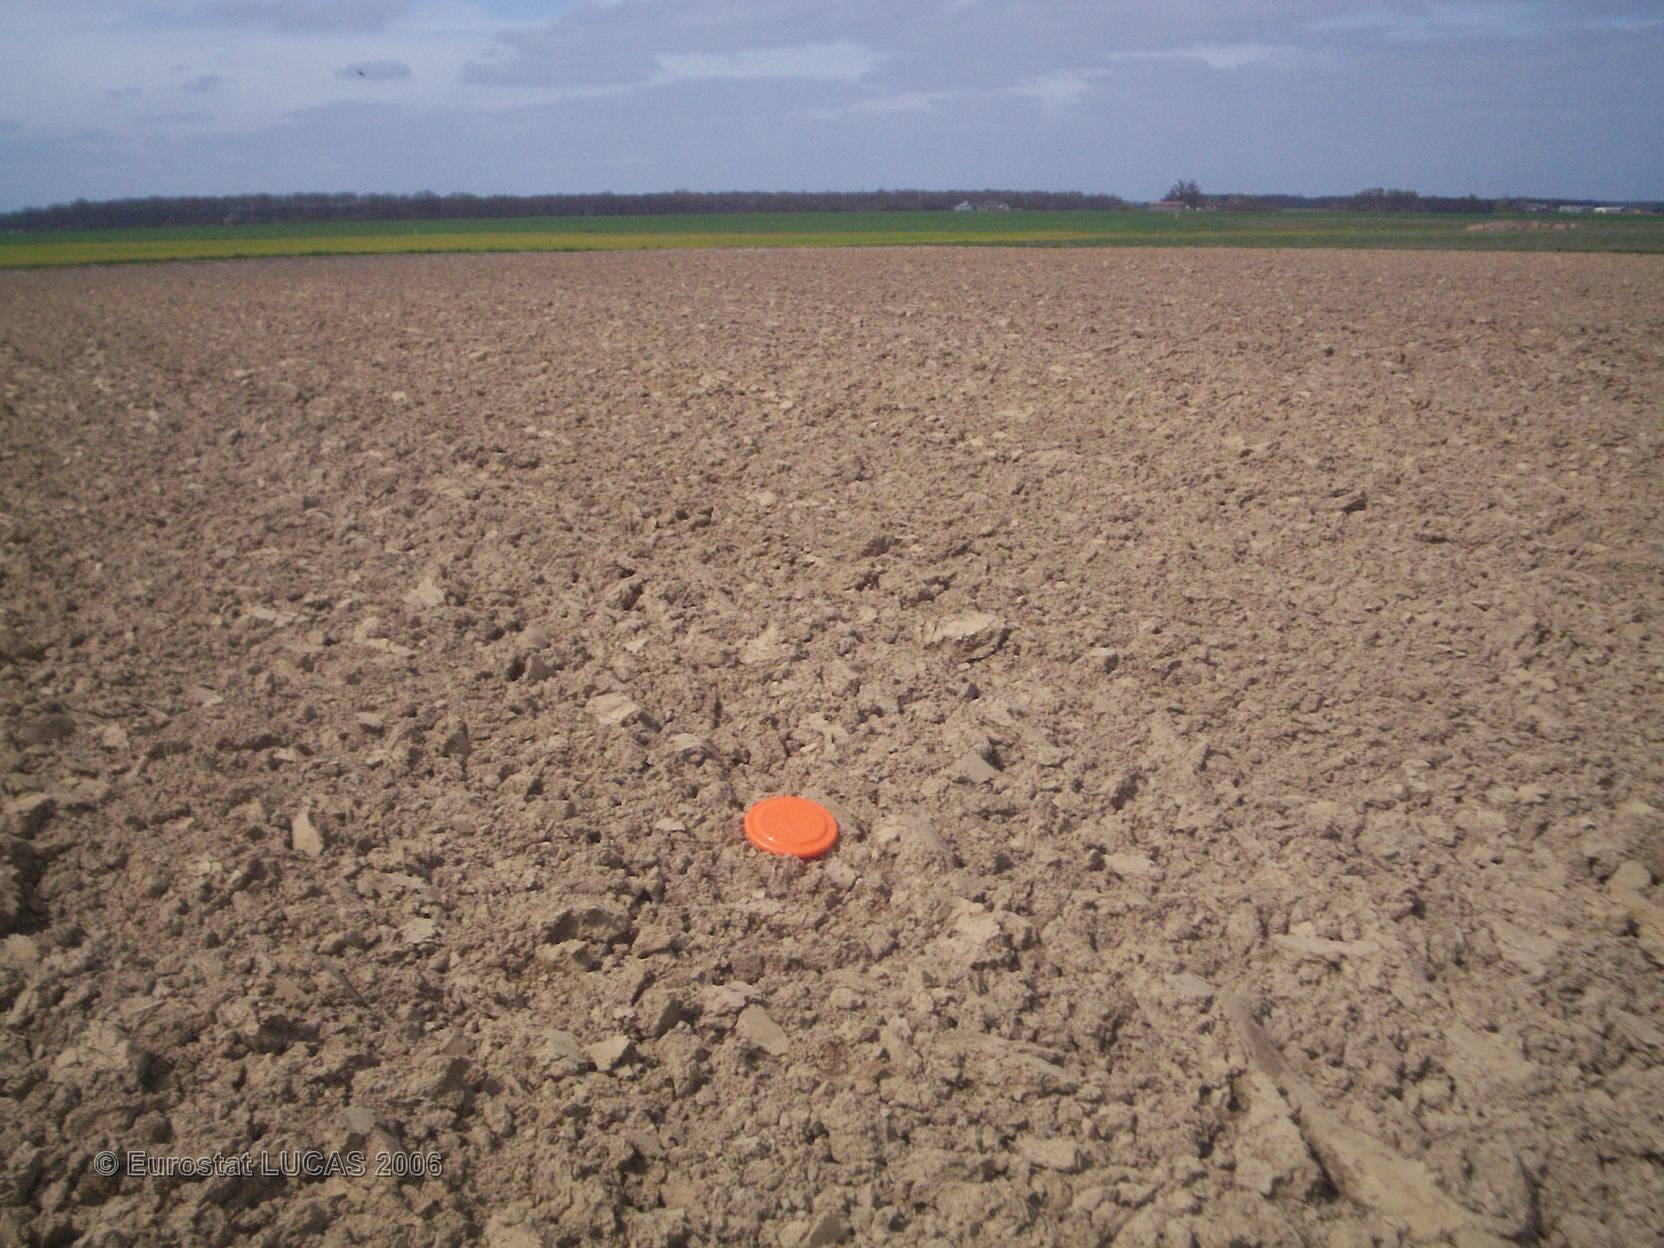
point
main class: Cropland
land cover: Maize
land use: Agriculture (excluding fallow land and kitchen gardens)
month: May
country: FR
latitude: 47.1845
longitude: 0.5712
